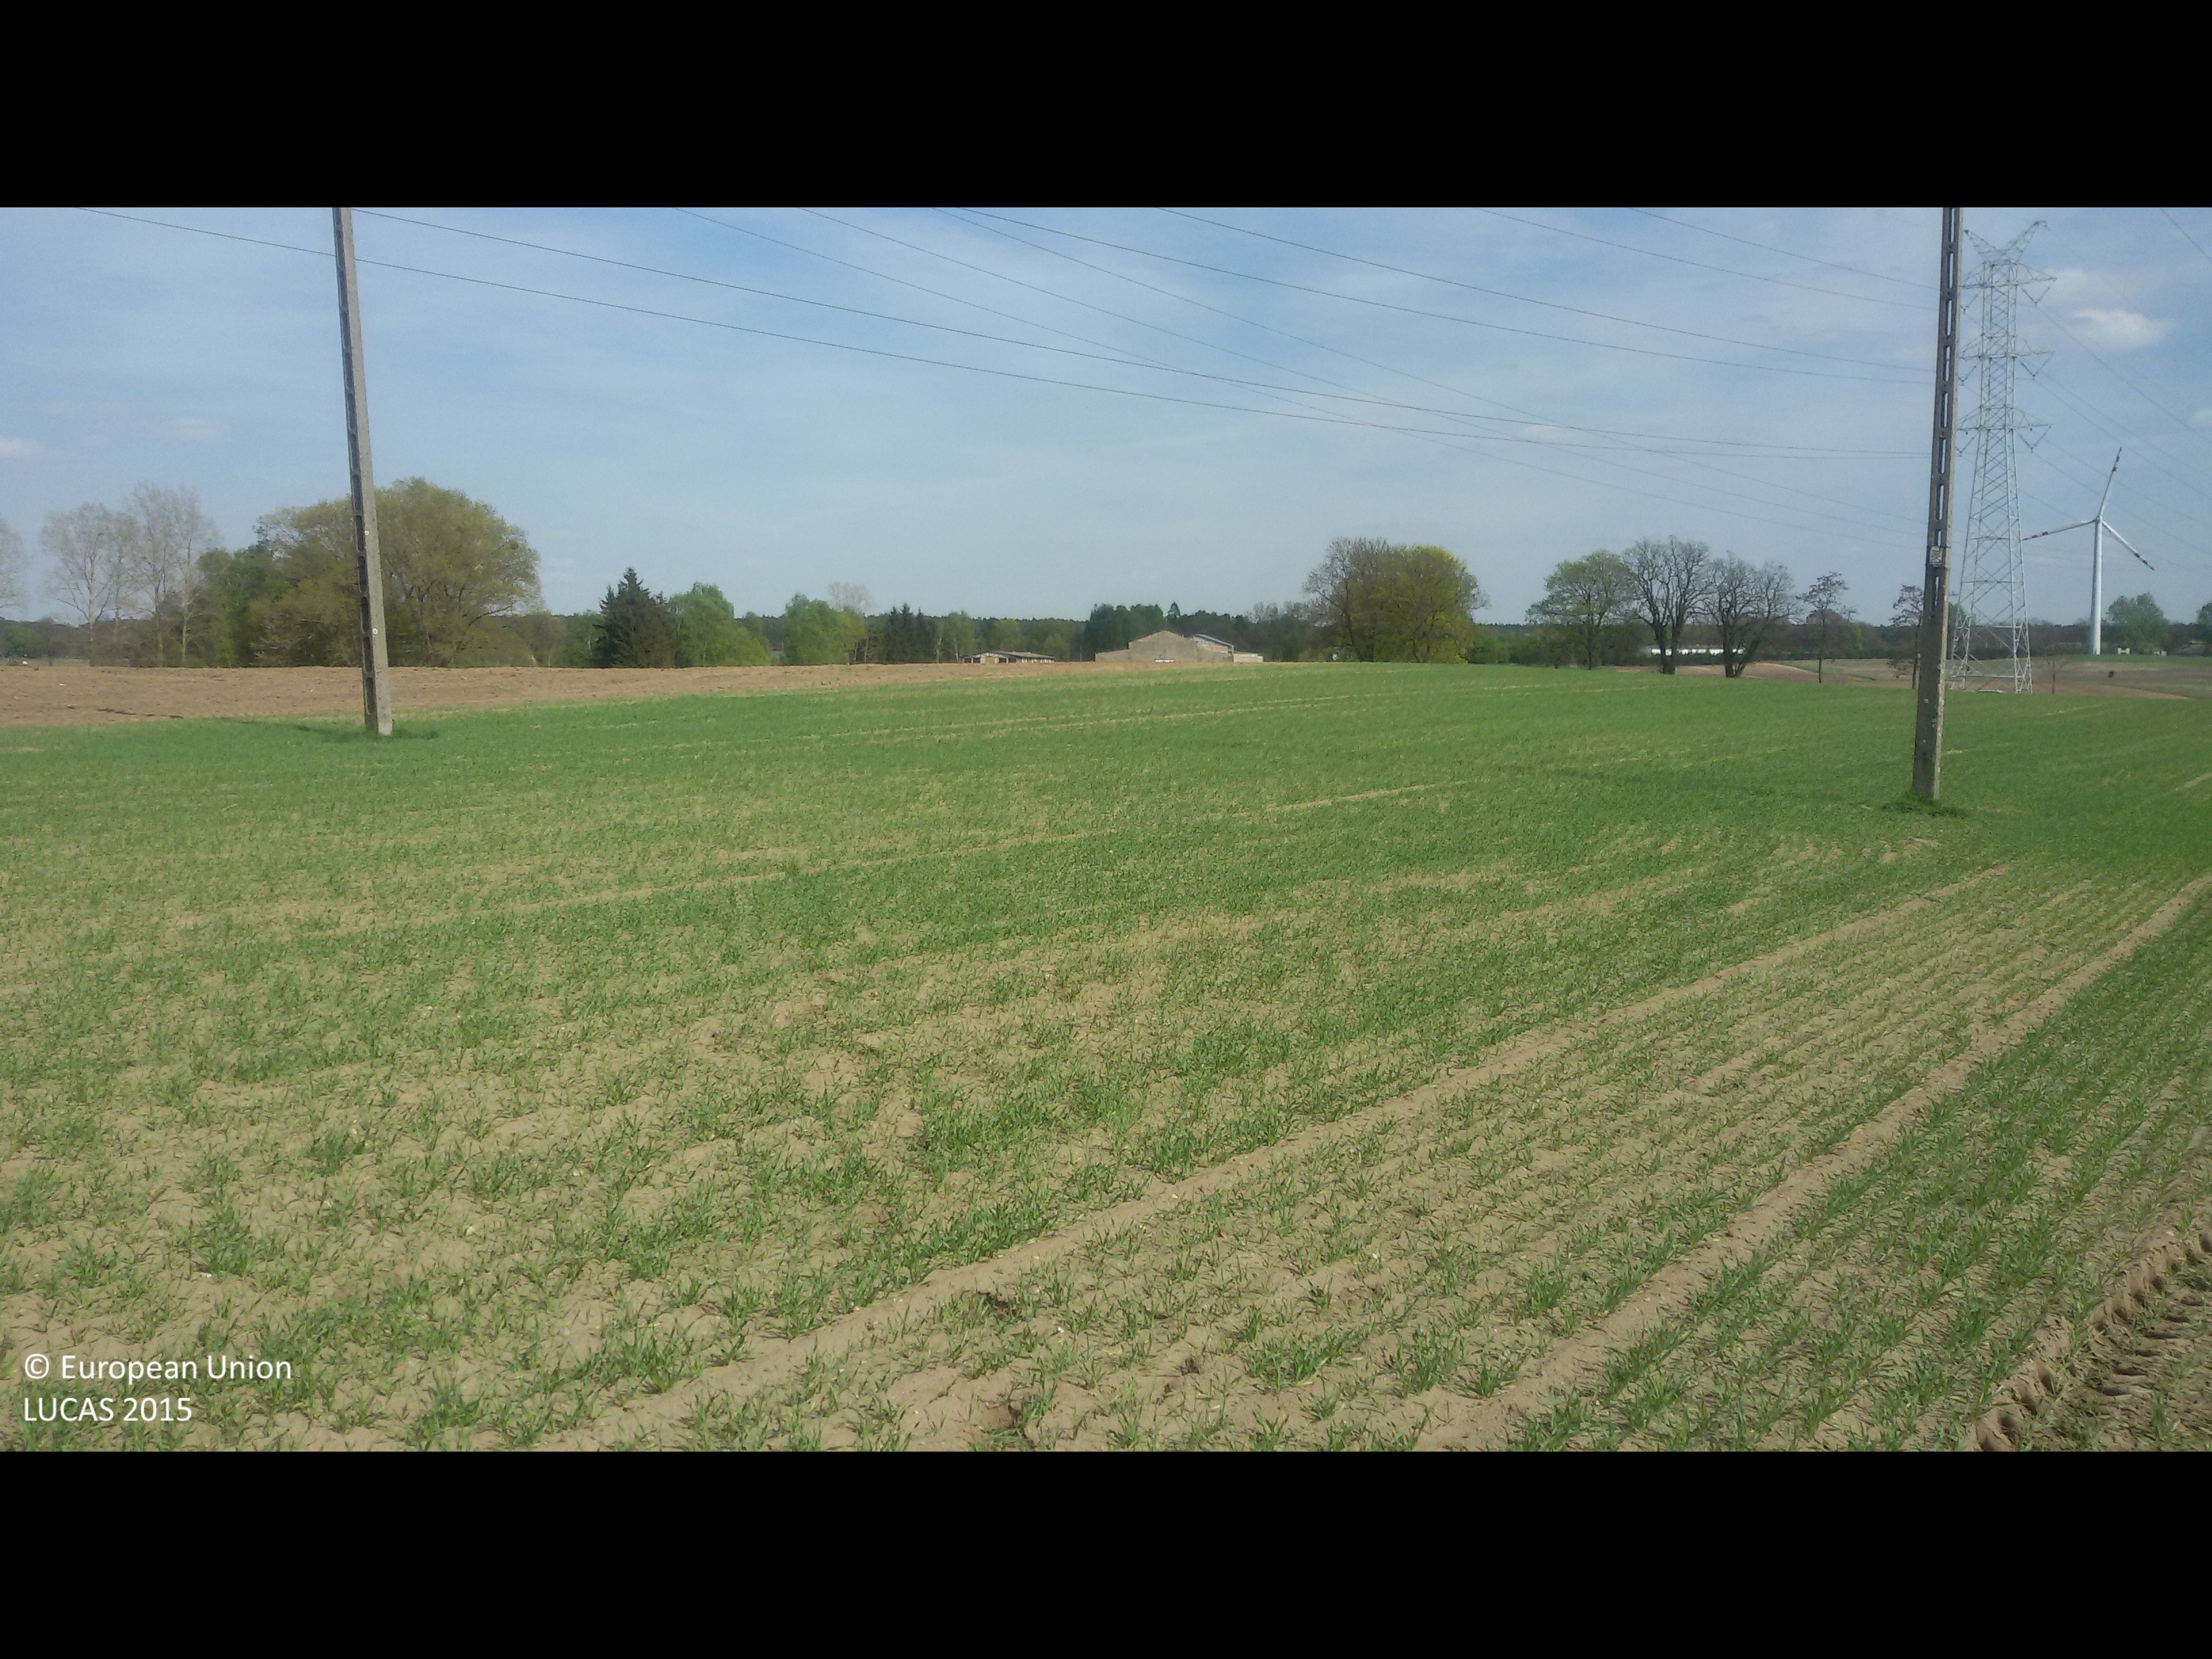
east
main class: Cropland
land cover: Barley
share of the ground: 25 - 50 %
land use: Agriculture (excluding fallow land and kitchen gardens)
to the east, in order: Barley; Electric lines; Barley; Electric lines; Barley; Spontaneously vegetated surfaces; Maize; Other bare soil; Grassland without tree/shrub cover; Other bare soil
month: May
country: PL
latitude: 52.9635
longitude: 17.0219
